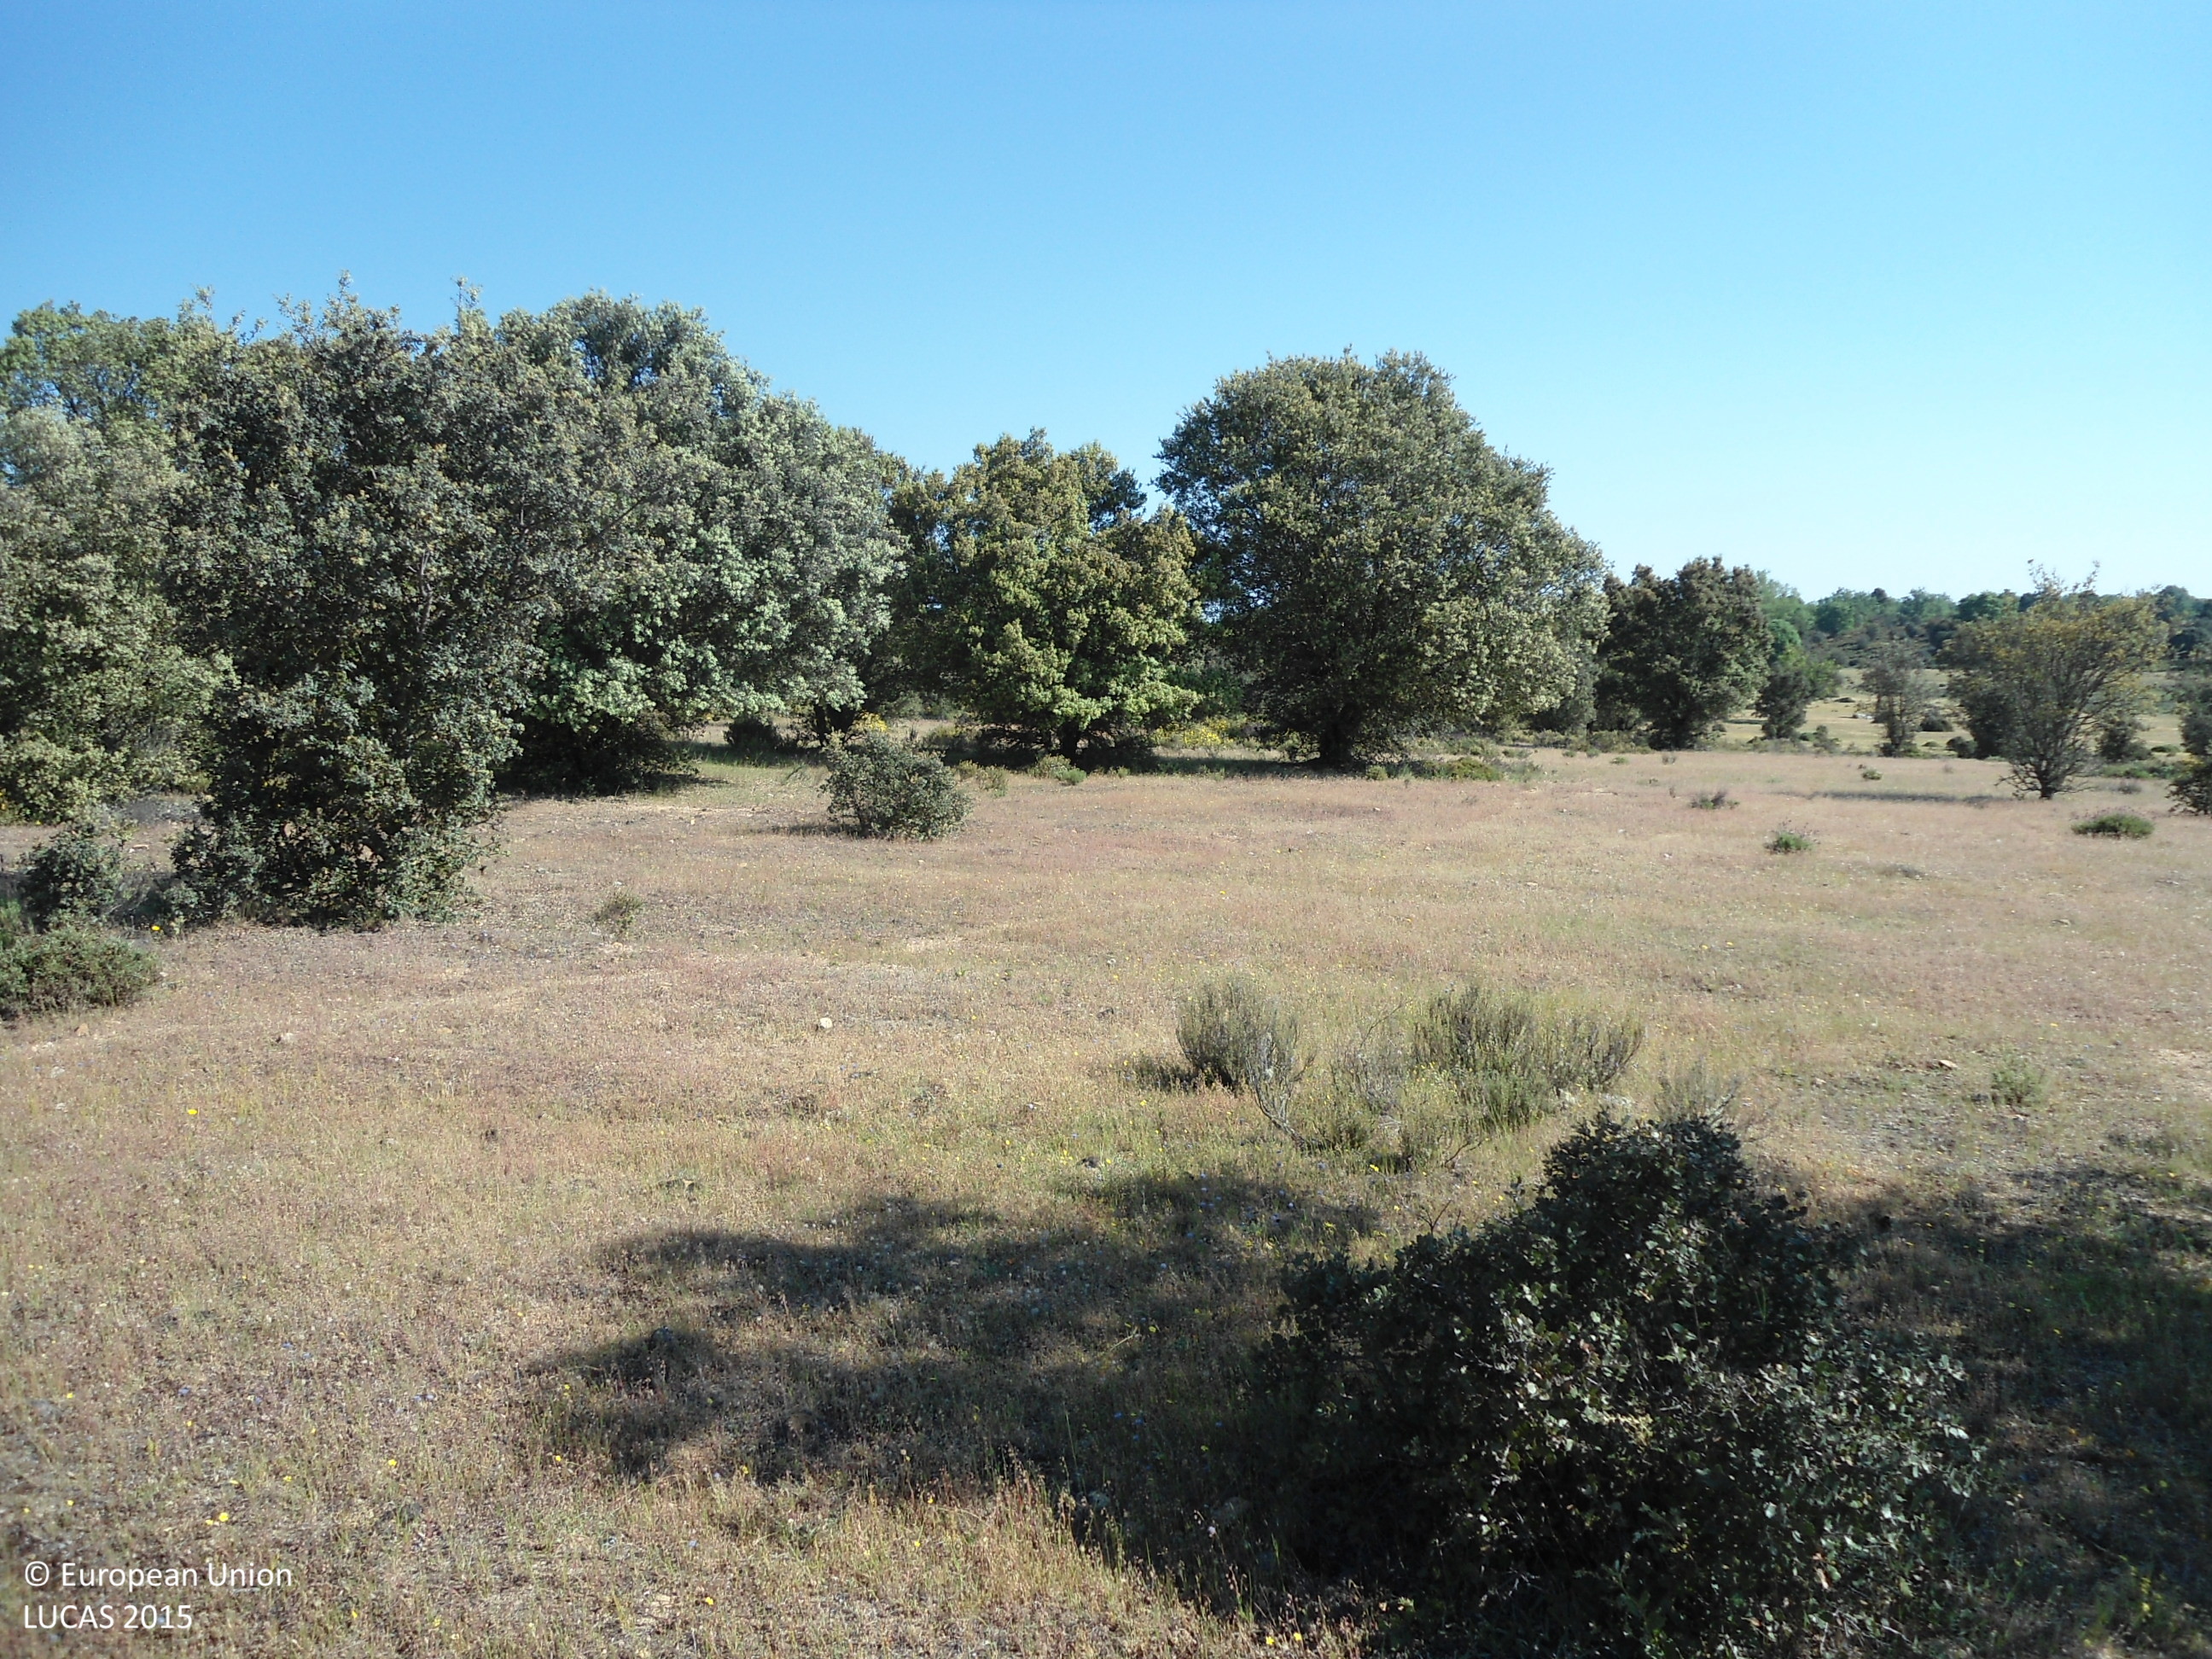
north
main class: Grassland
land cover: Grassland with sparse tree/shrub cover
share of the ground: 50 - 75 %
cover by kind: herbaceous plants 85 %, shrubs 10 %, broadleaved forest trees 5 %
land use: Agriculture (excluding fallow land and kitchen gardens)
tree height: < 5 m
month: June
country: ES
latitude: 42.0335
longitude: -6.2297
